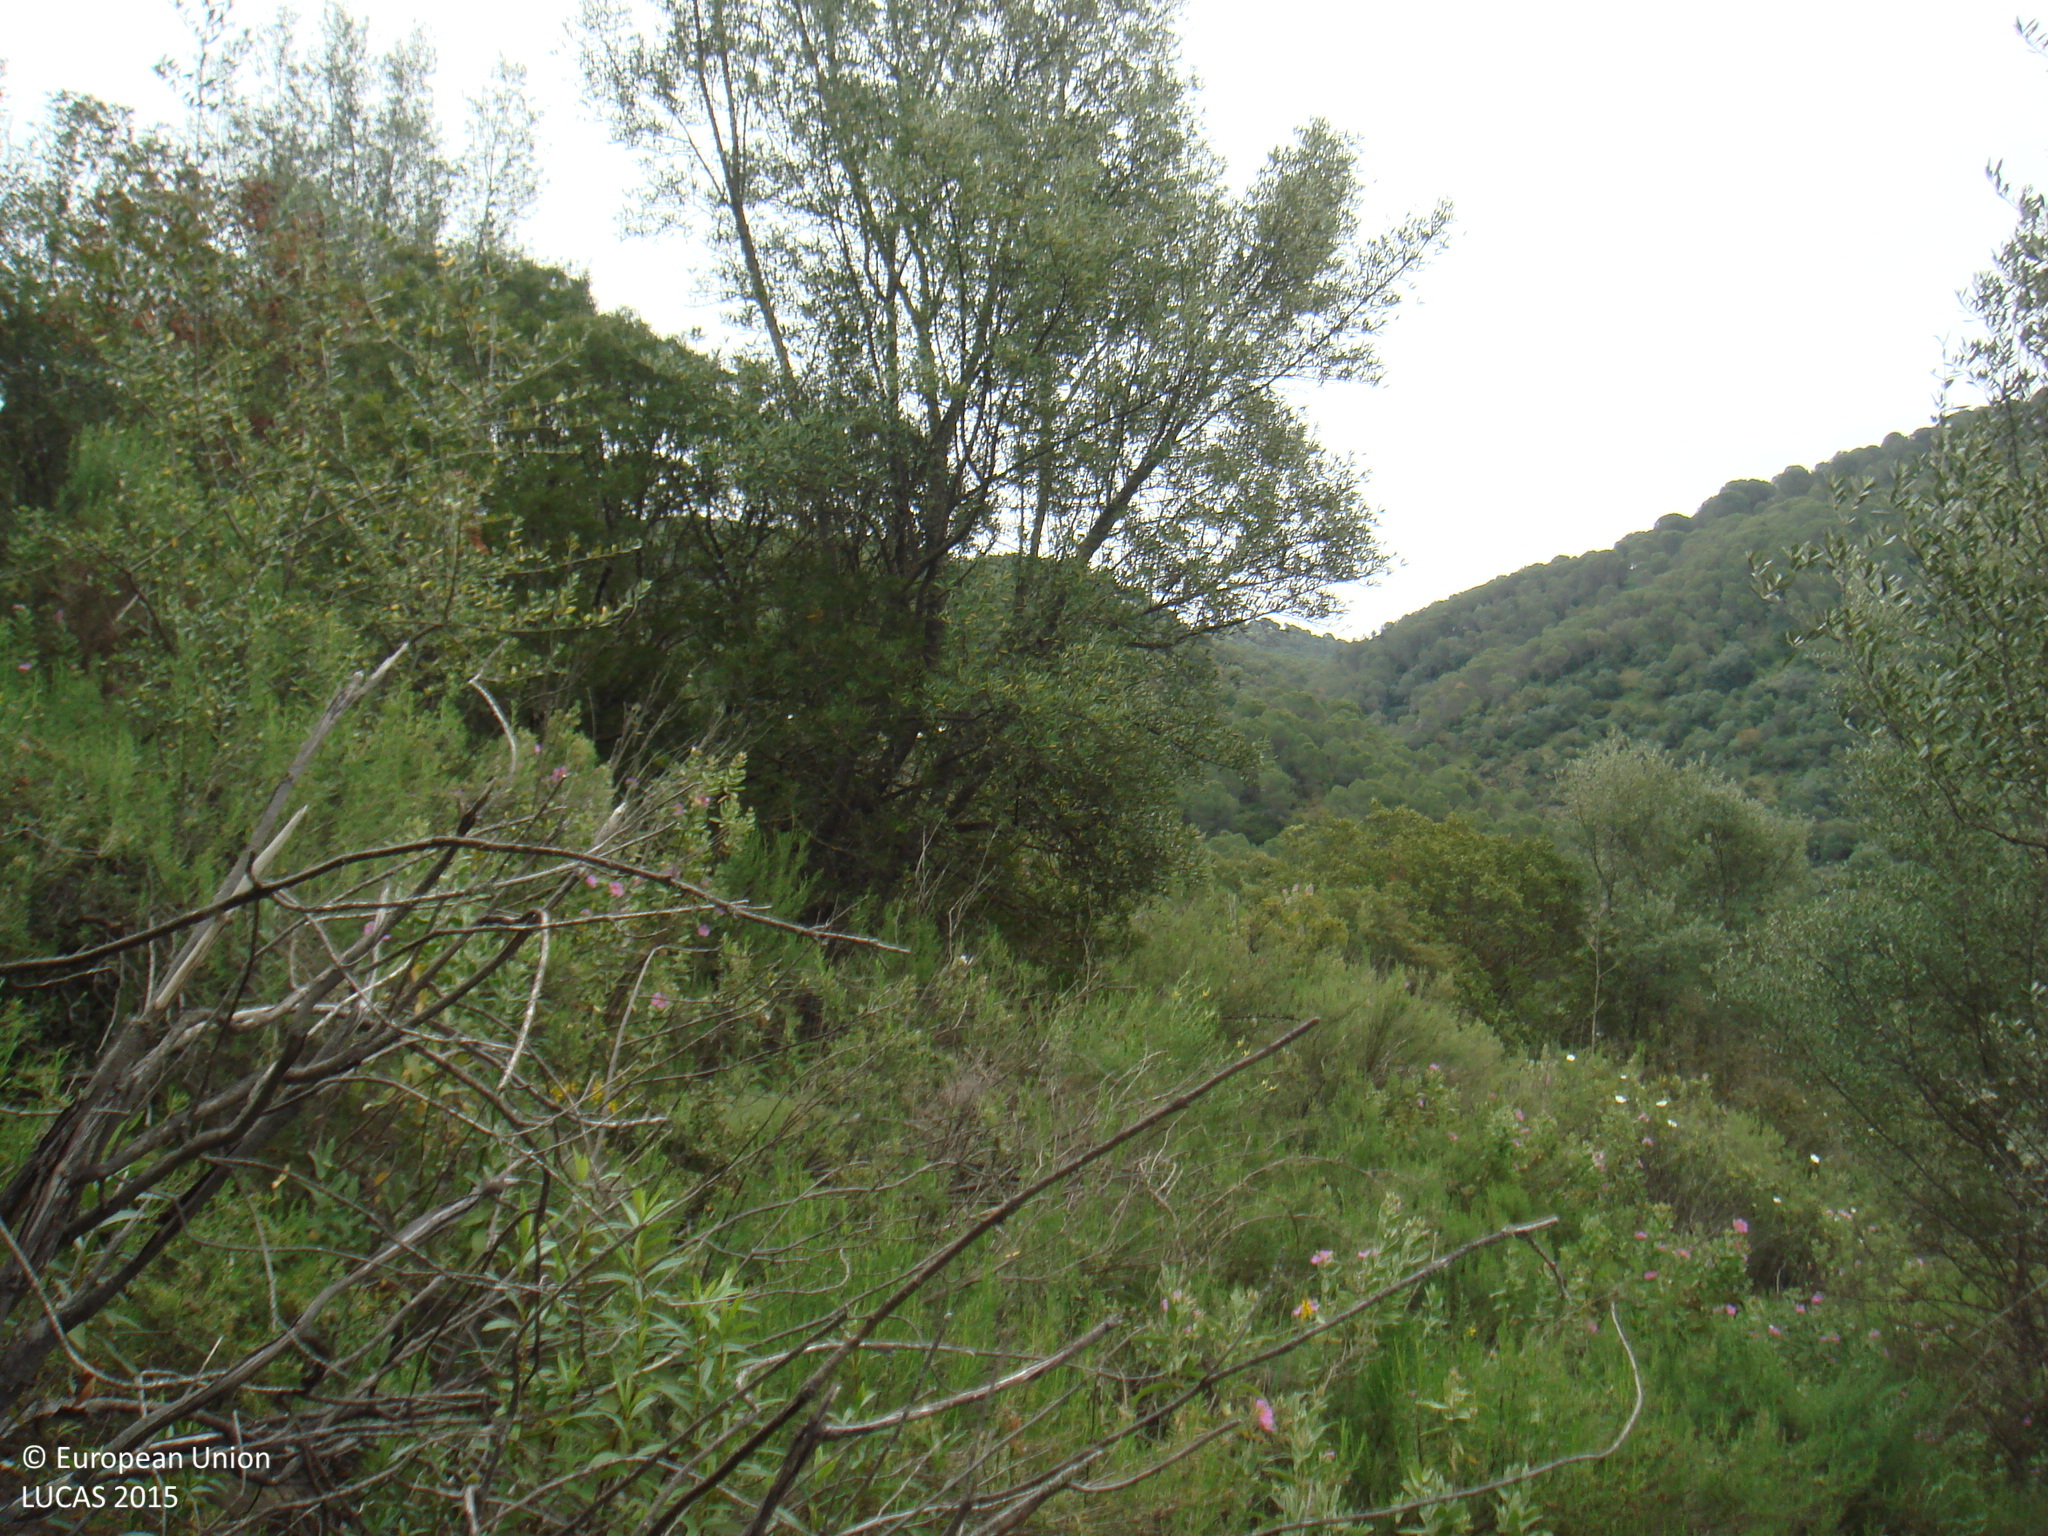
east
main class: Shrubland
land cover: Shrubland with sparse tree cover
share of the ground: 10 - 25 %
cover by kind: shrubs 55 %, herbaceous plants 40 %, broadleaved forest trees 5 %
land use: Forestry
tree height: < 5 m
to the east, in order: Shrubland with sparse tree cover; Inland fresh running water; Shrubland with sparse tree cover
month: April
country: ES
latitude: 38.0046
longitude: -5.2266
